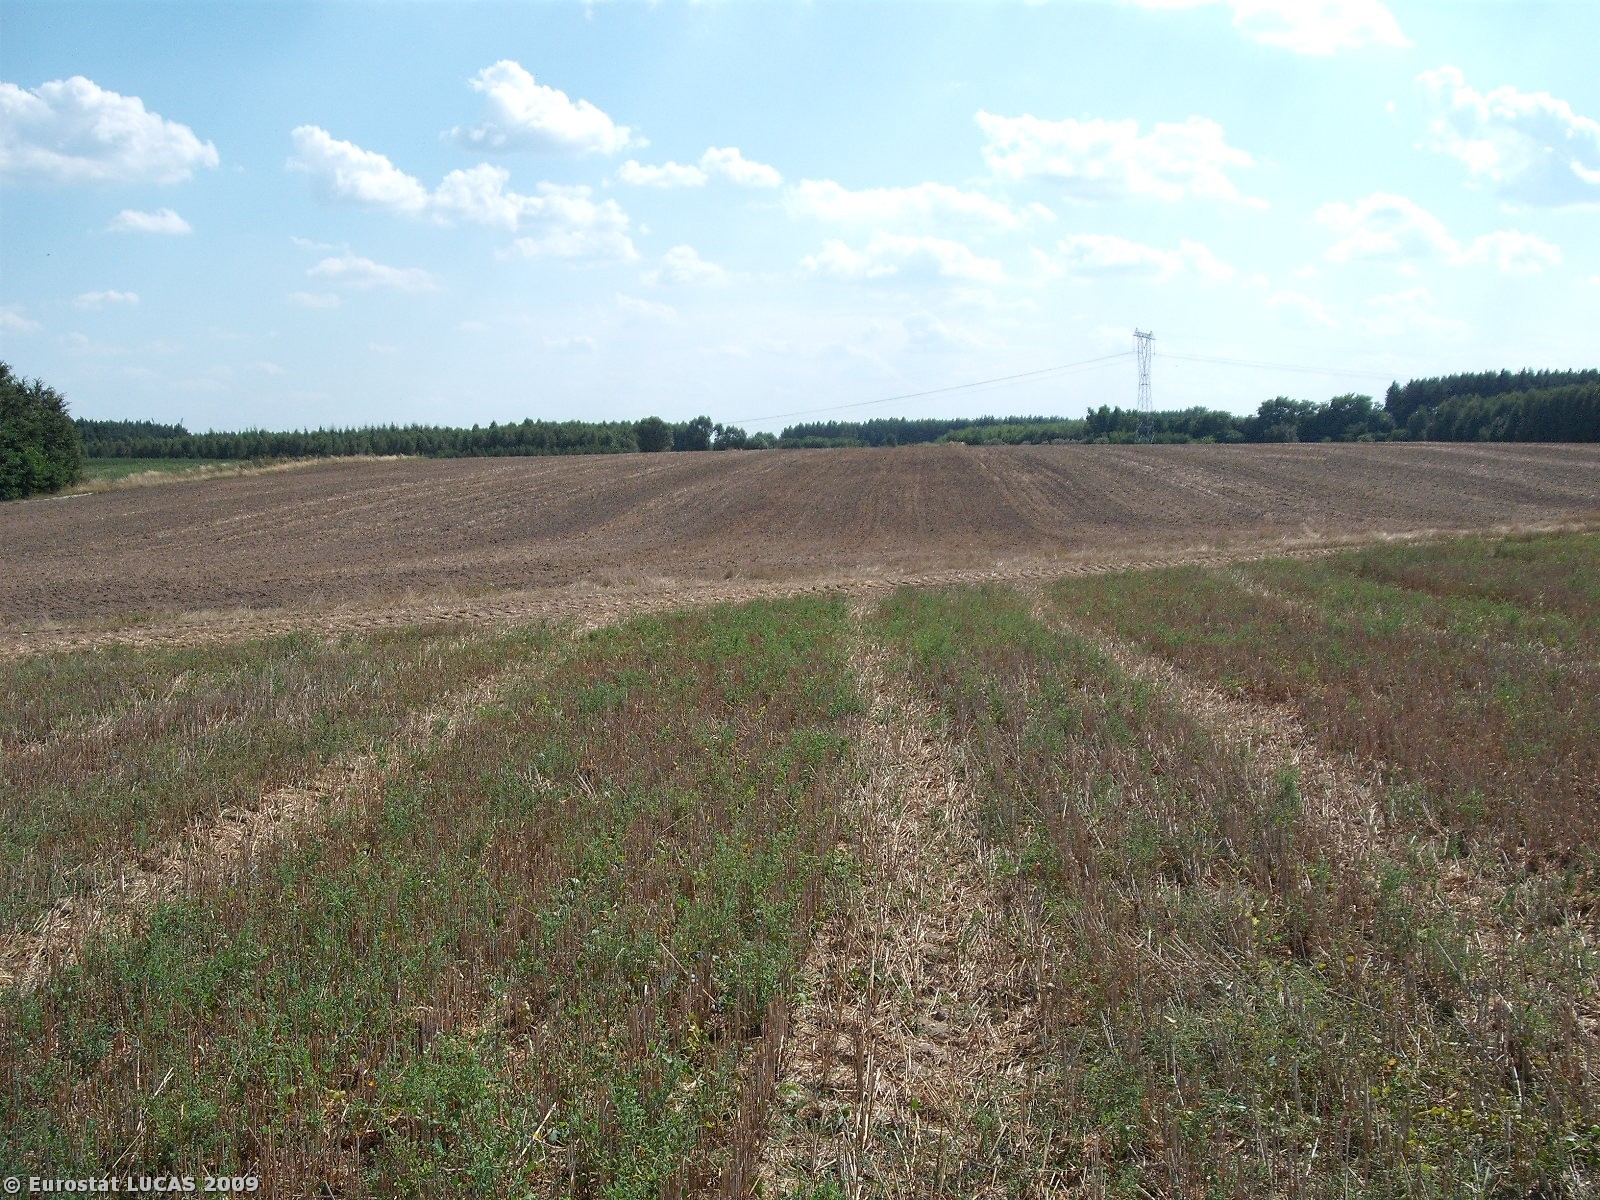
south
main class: Cropland
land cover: Triticale
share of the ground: < 10 %
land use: Agriculture (excluding fallow land and kitchen gardens)
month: August
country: PL
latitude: 50.5681
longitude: 20.7000
